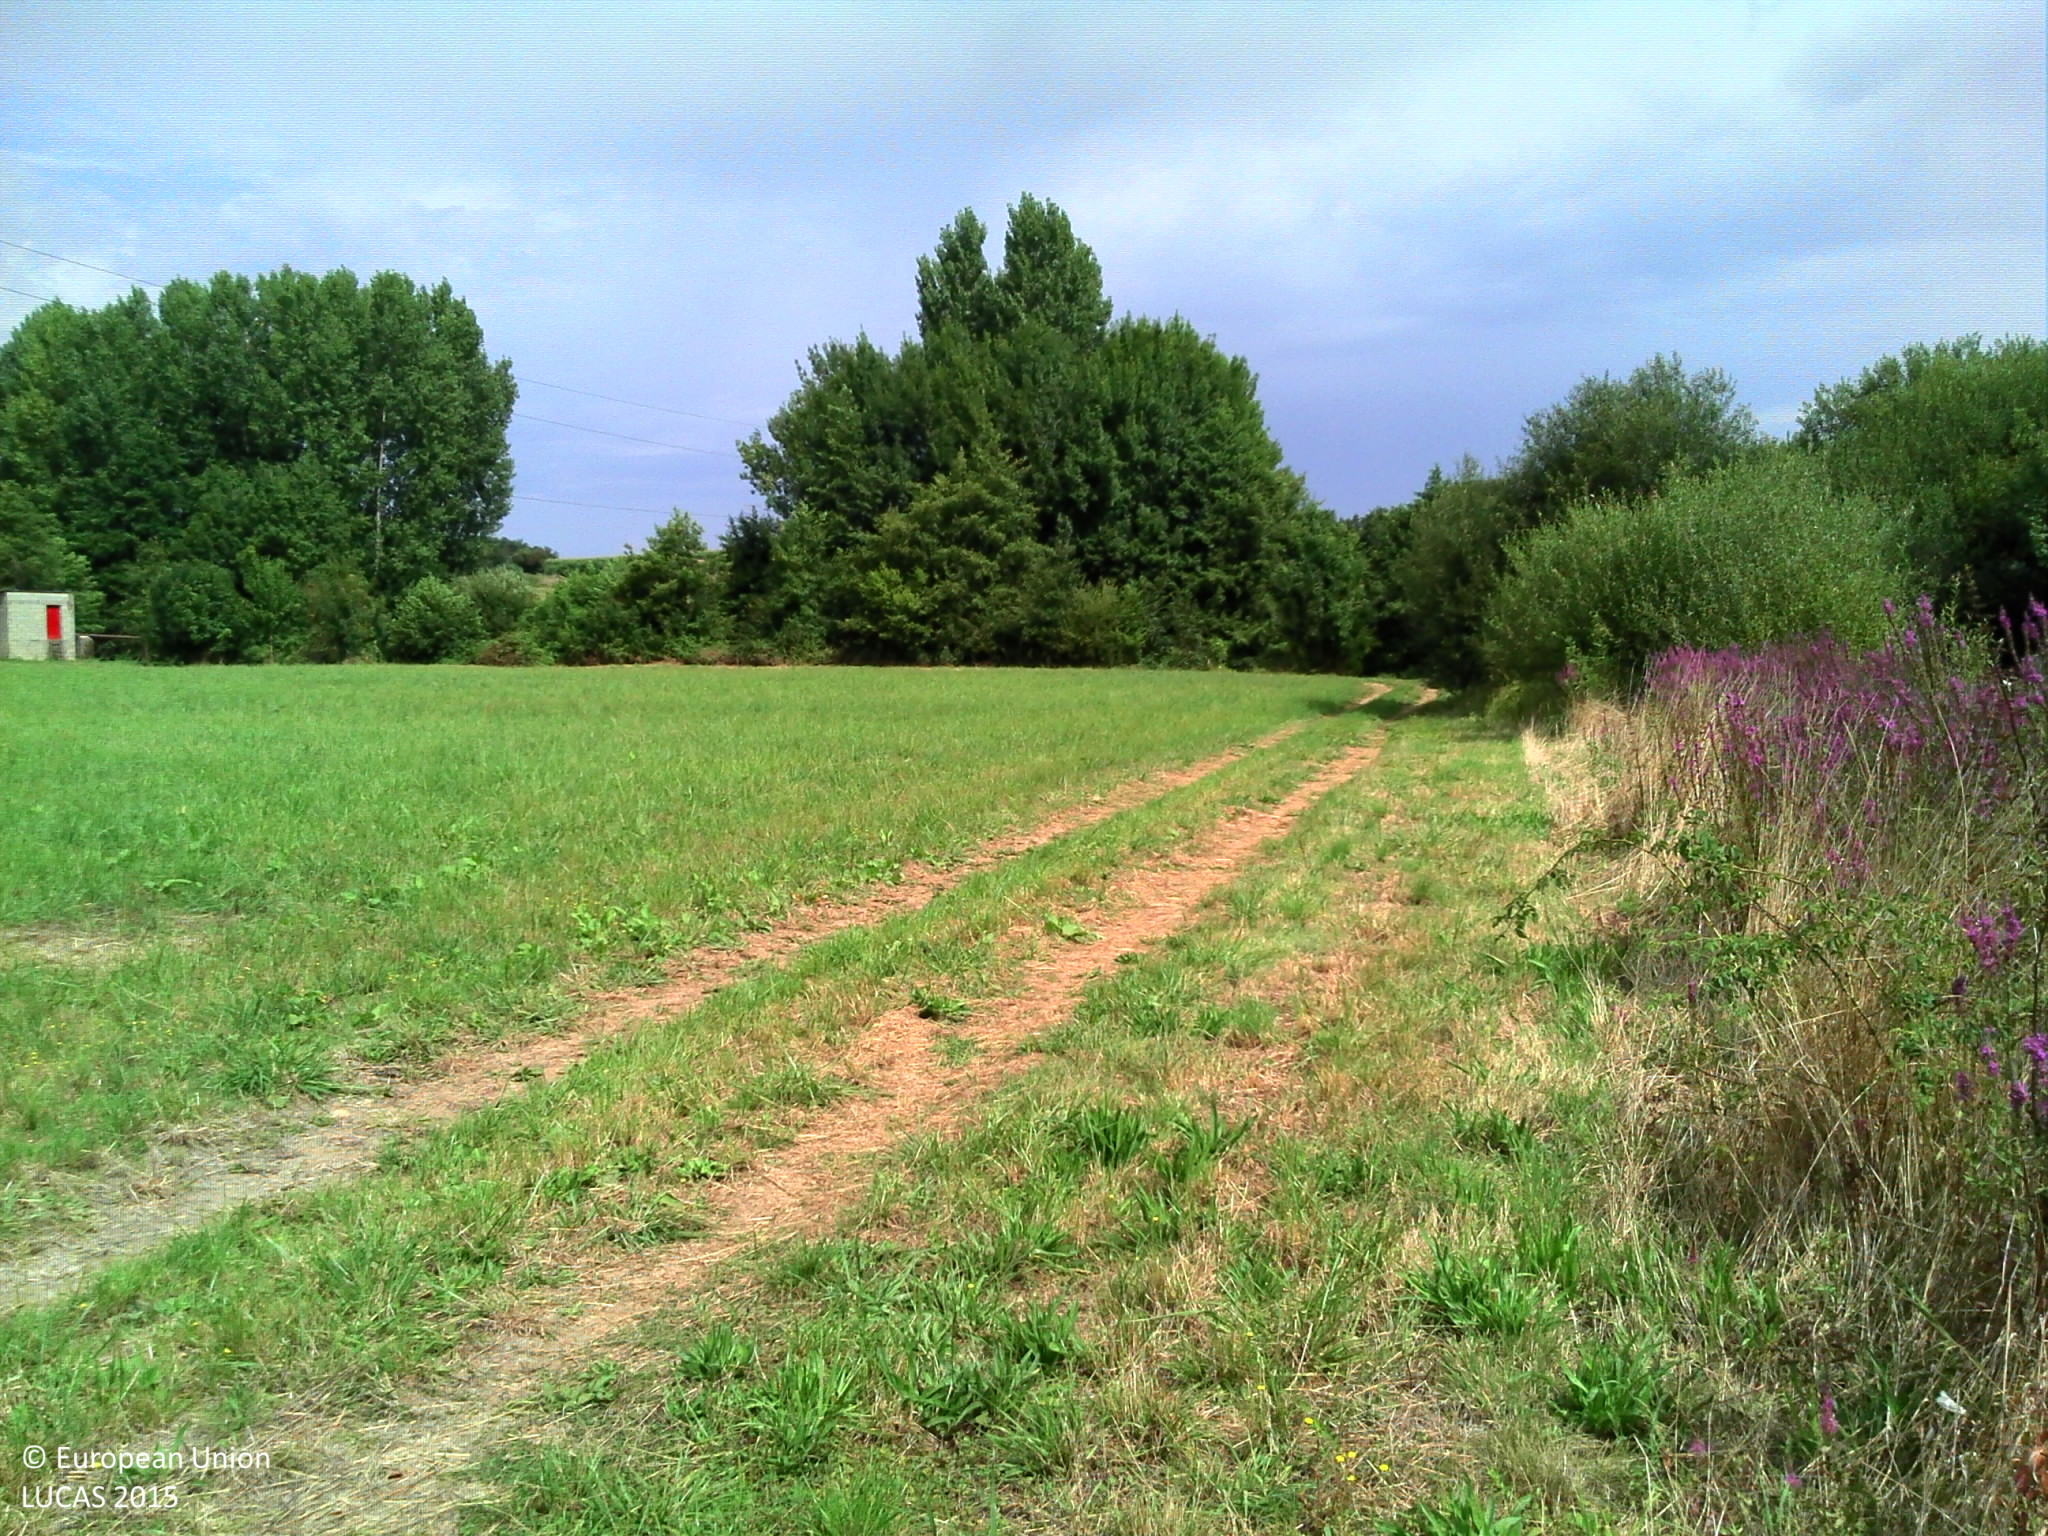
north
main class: Grassland
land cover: Grassland without tree/shrub cover
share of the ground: > 75 %
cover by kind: herbaceous plants 100 %
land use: Agriculture (excluding fallow land and kitchen gardens)
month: August
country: FR
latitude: 46.1415
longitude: 0.2601
